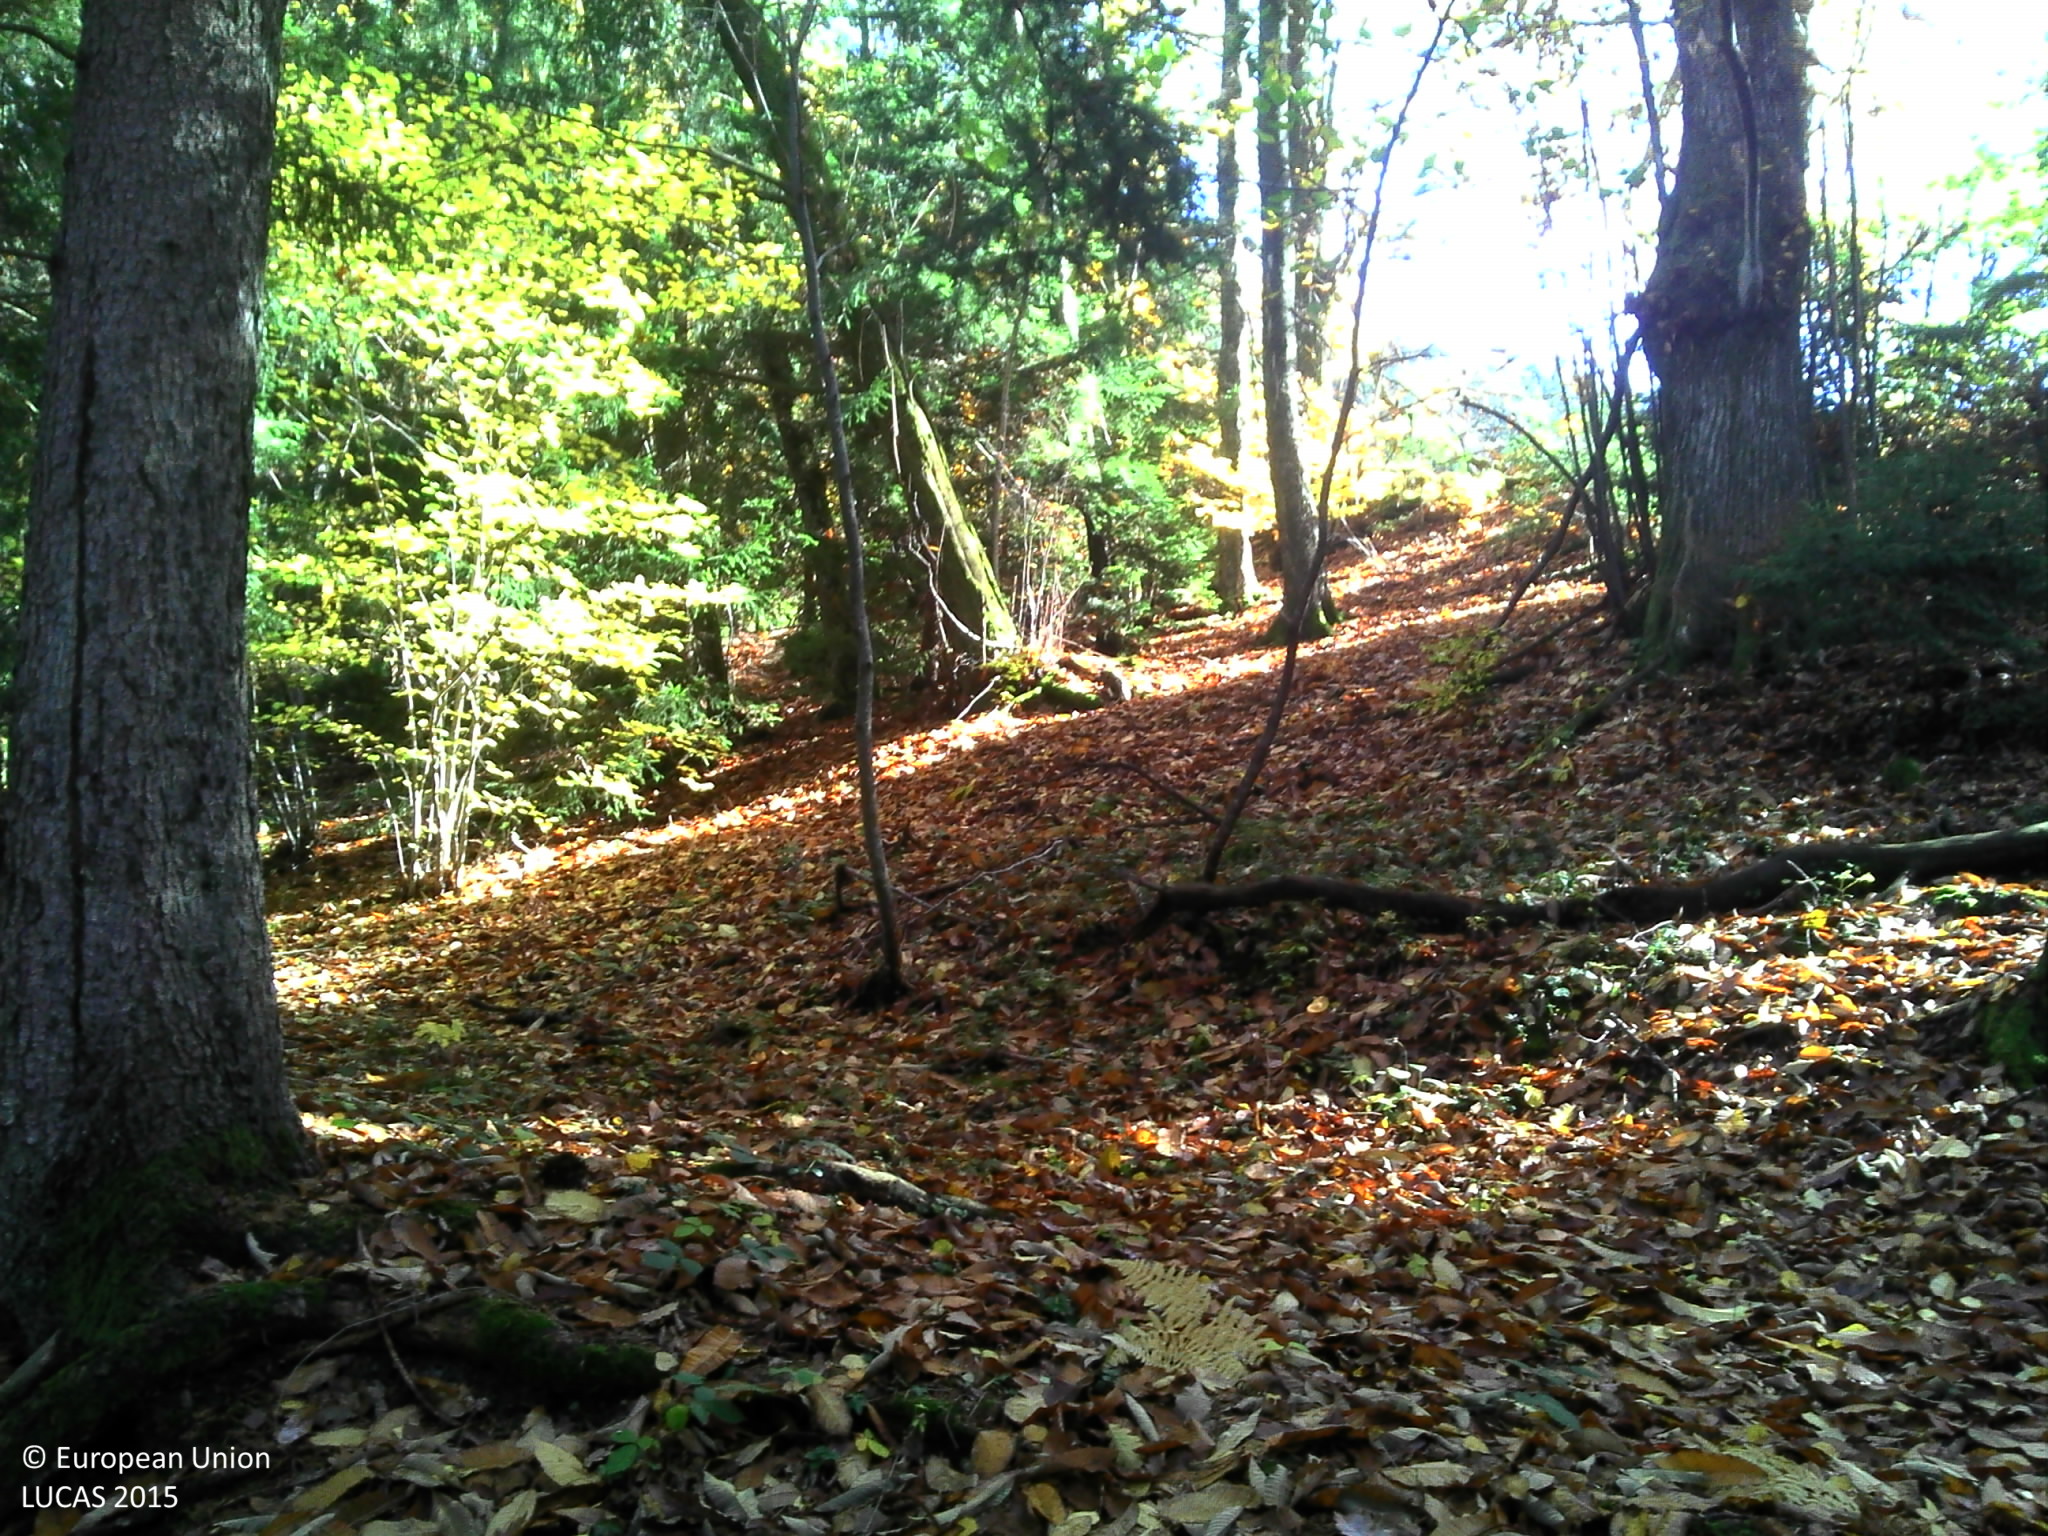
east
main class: Woodland
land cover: Spruce dominated mixed woodland
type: hemiboreal forest and nemoral coniferous forest and mixed broadleaved-coniferous forest
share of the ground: > 75 %
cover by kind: coniferous forest trees 45 %, broadleaved forest trees 45 %, unconsolidated bare surface 10 %
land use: Forestry
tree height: > 5 m
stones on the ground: < 10 %
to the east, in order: Spruce dominated mixed woodland; Tracks; Spruce dominated mixed woodland; Fences; Grassland without tree/shrub cover; Spruce dominated mixed woodland; Grass margins; Paved roads, cycling and walking lanes; Electric lines; Grass margins; Spruce dominated mixed woodland
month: October
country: FR
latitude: 45.4705
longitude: 6.1547
